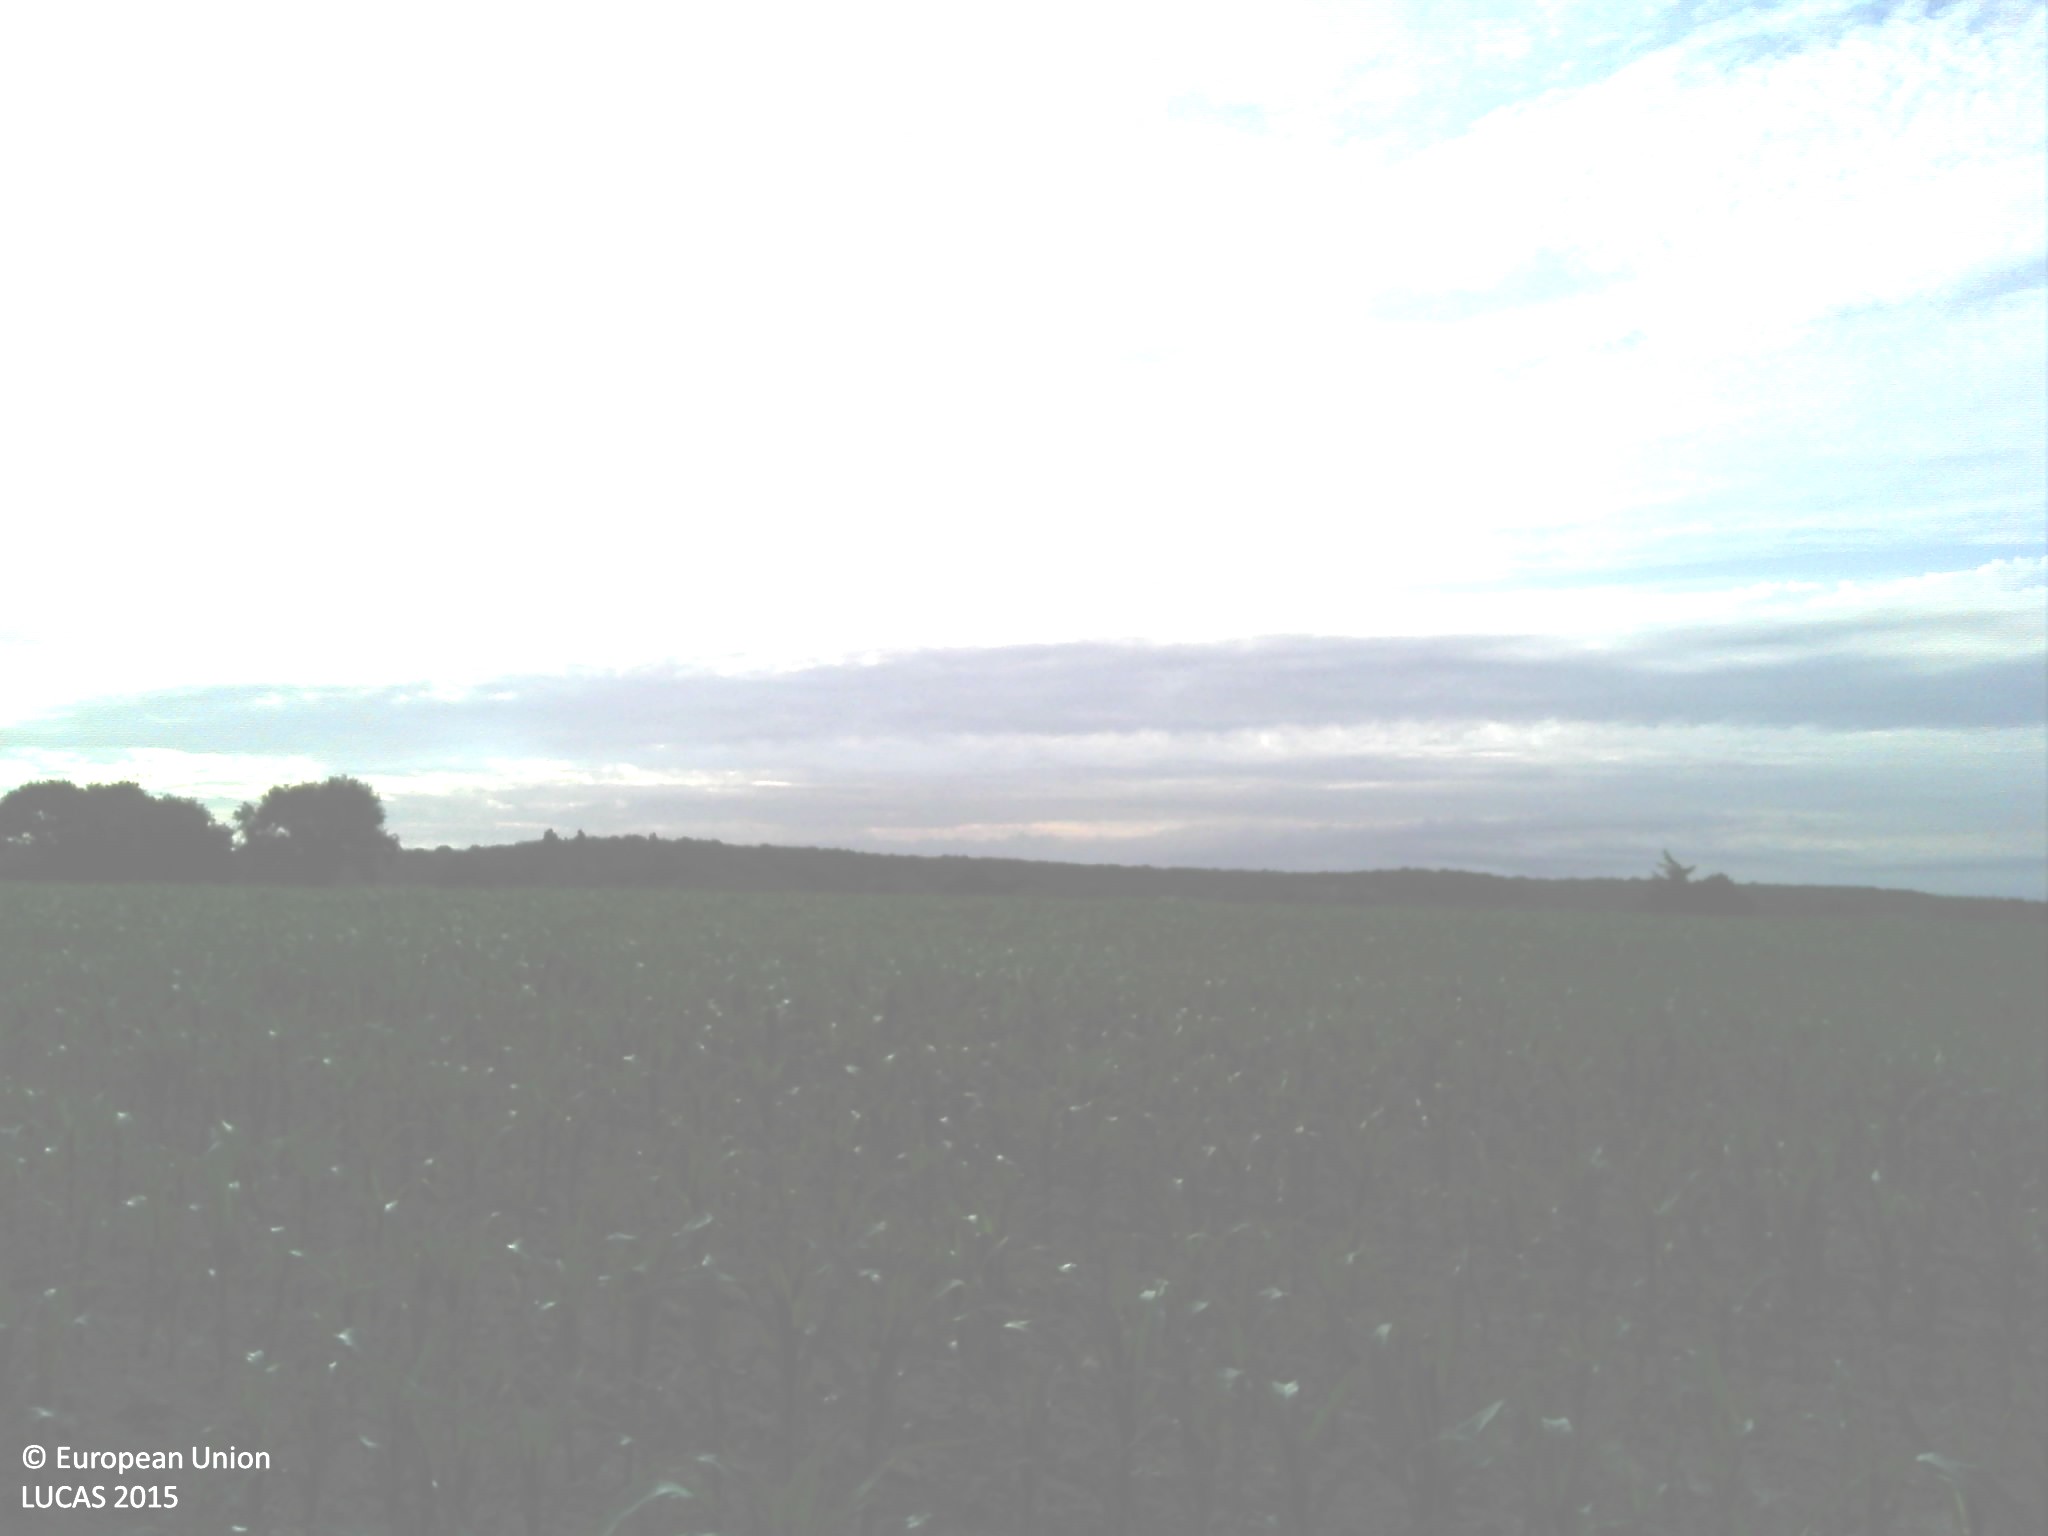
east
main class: Cropland
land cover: Maize
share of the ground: 25 - 50 %
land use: Agriculture (excluding fallow land and kitchen gardens)
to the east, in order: Maize
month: July
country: FR
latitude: 47.7885
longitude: 0.4329
